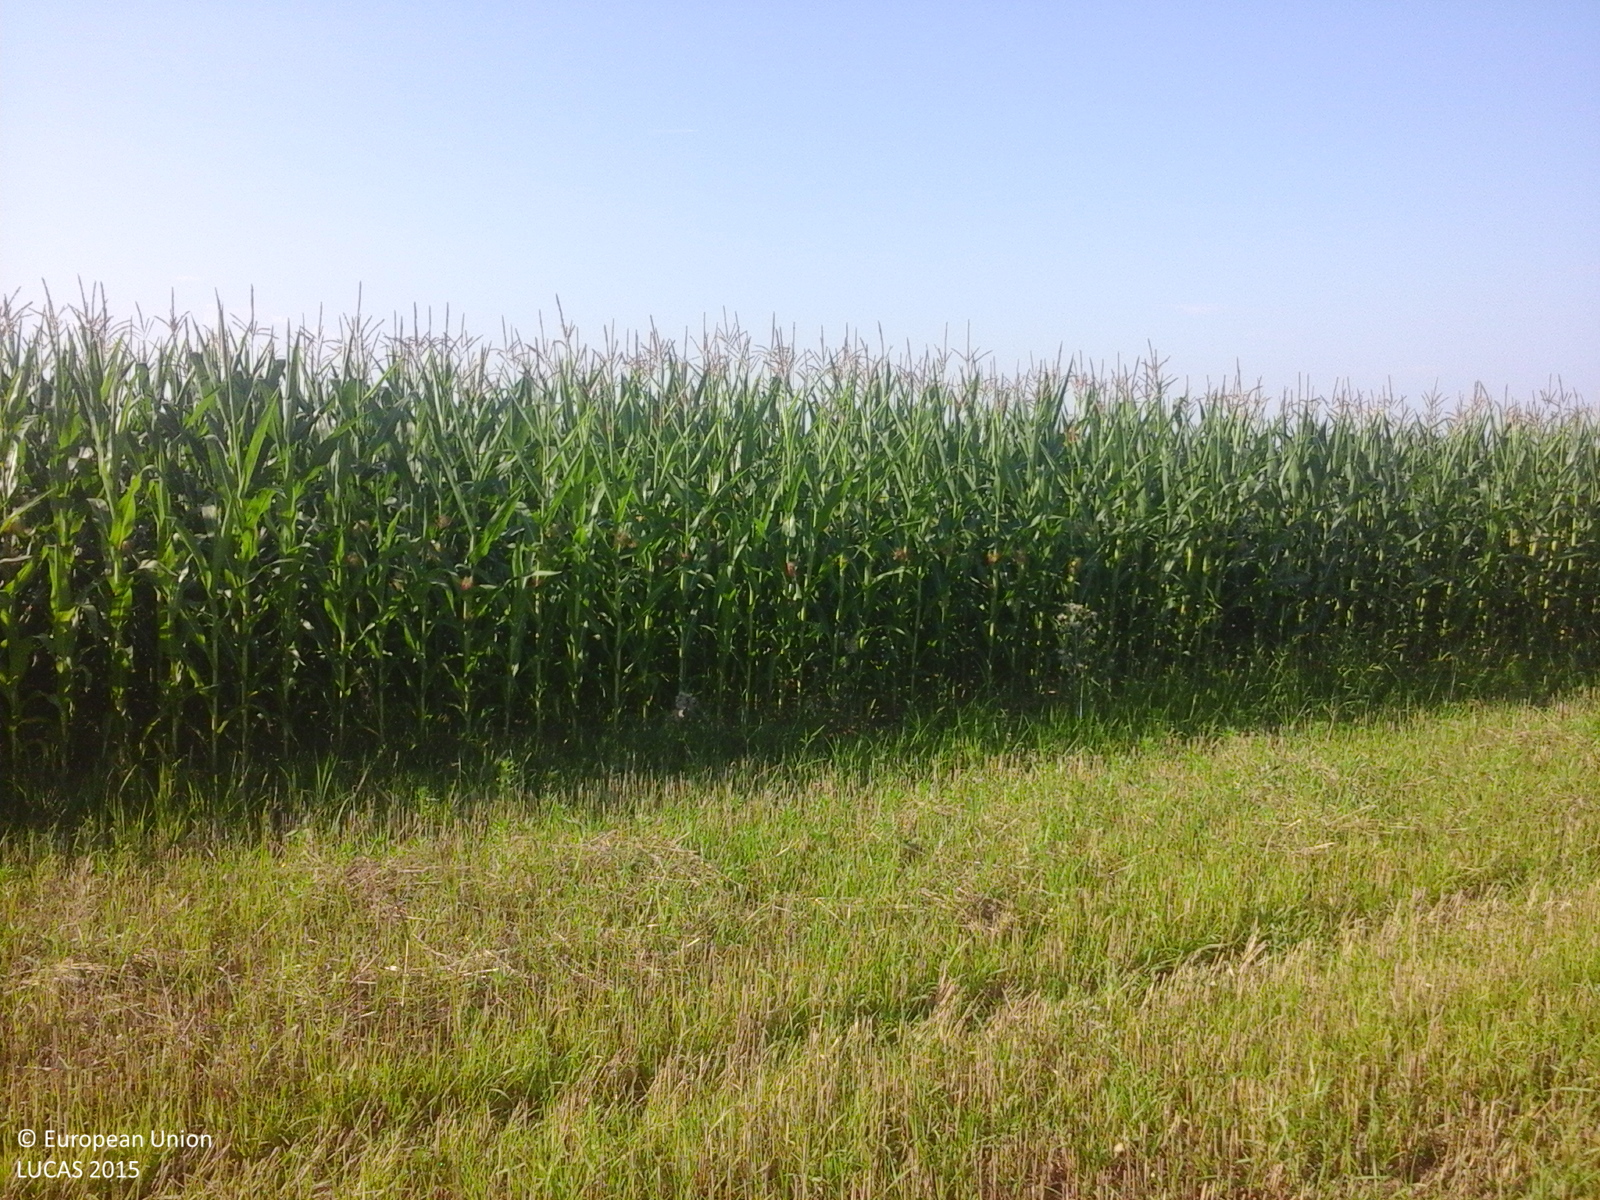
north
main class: Cropland
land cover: Barley
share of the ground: < 10 %
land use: Agriculture (excluding fallow land and kitchen gardens)
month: July
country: RO
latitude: 44.2921
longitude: 24.2642
